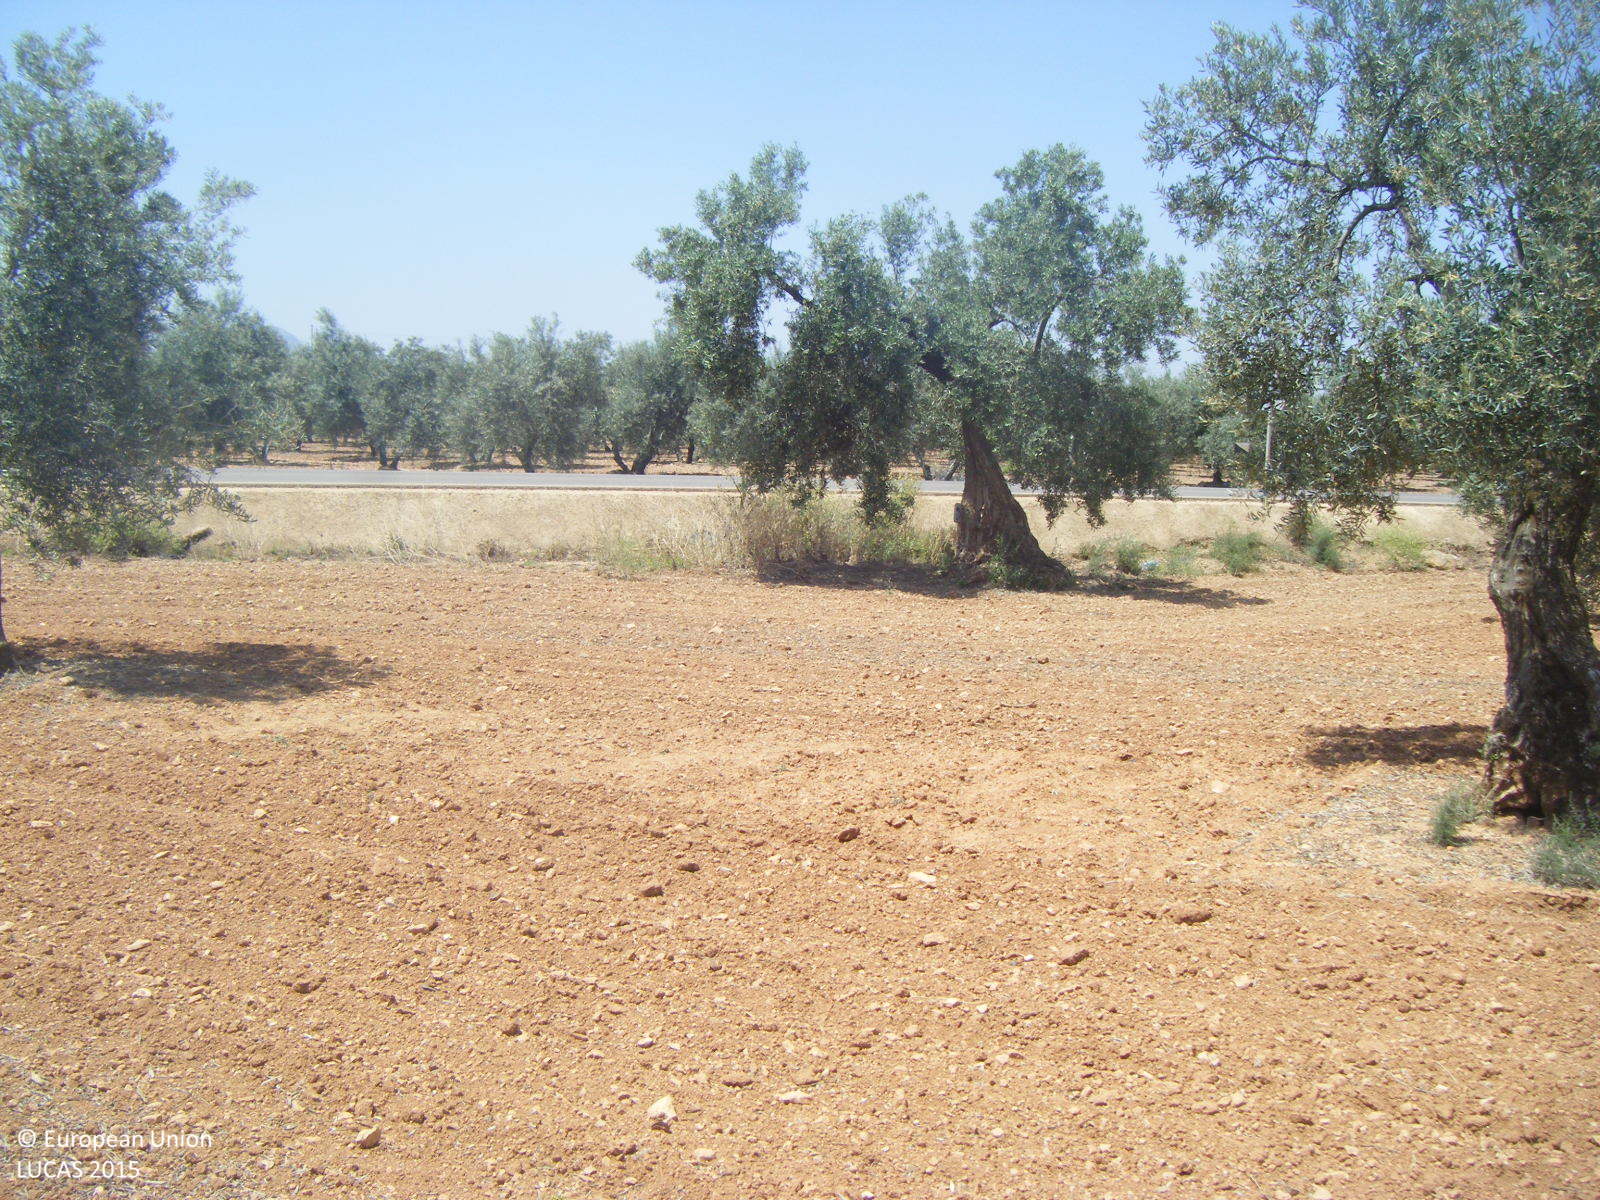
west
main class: Cropland
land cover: Olive groves
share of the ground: 25 - 50 %
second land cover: Other bare soil
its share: > 75 %
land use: Agriculture (excluding fallow land and kitchen gardens)
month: May
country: ES
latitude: 37.3187
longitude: -4.7986
